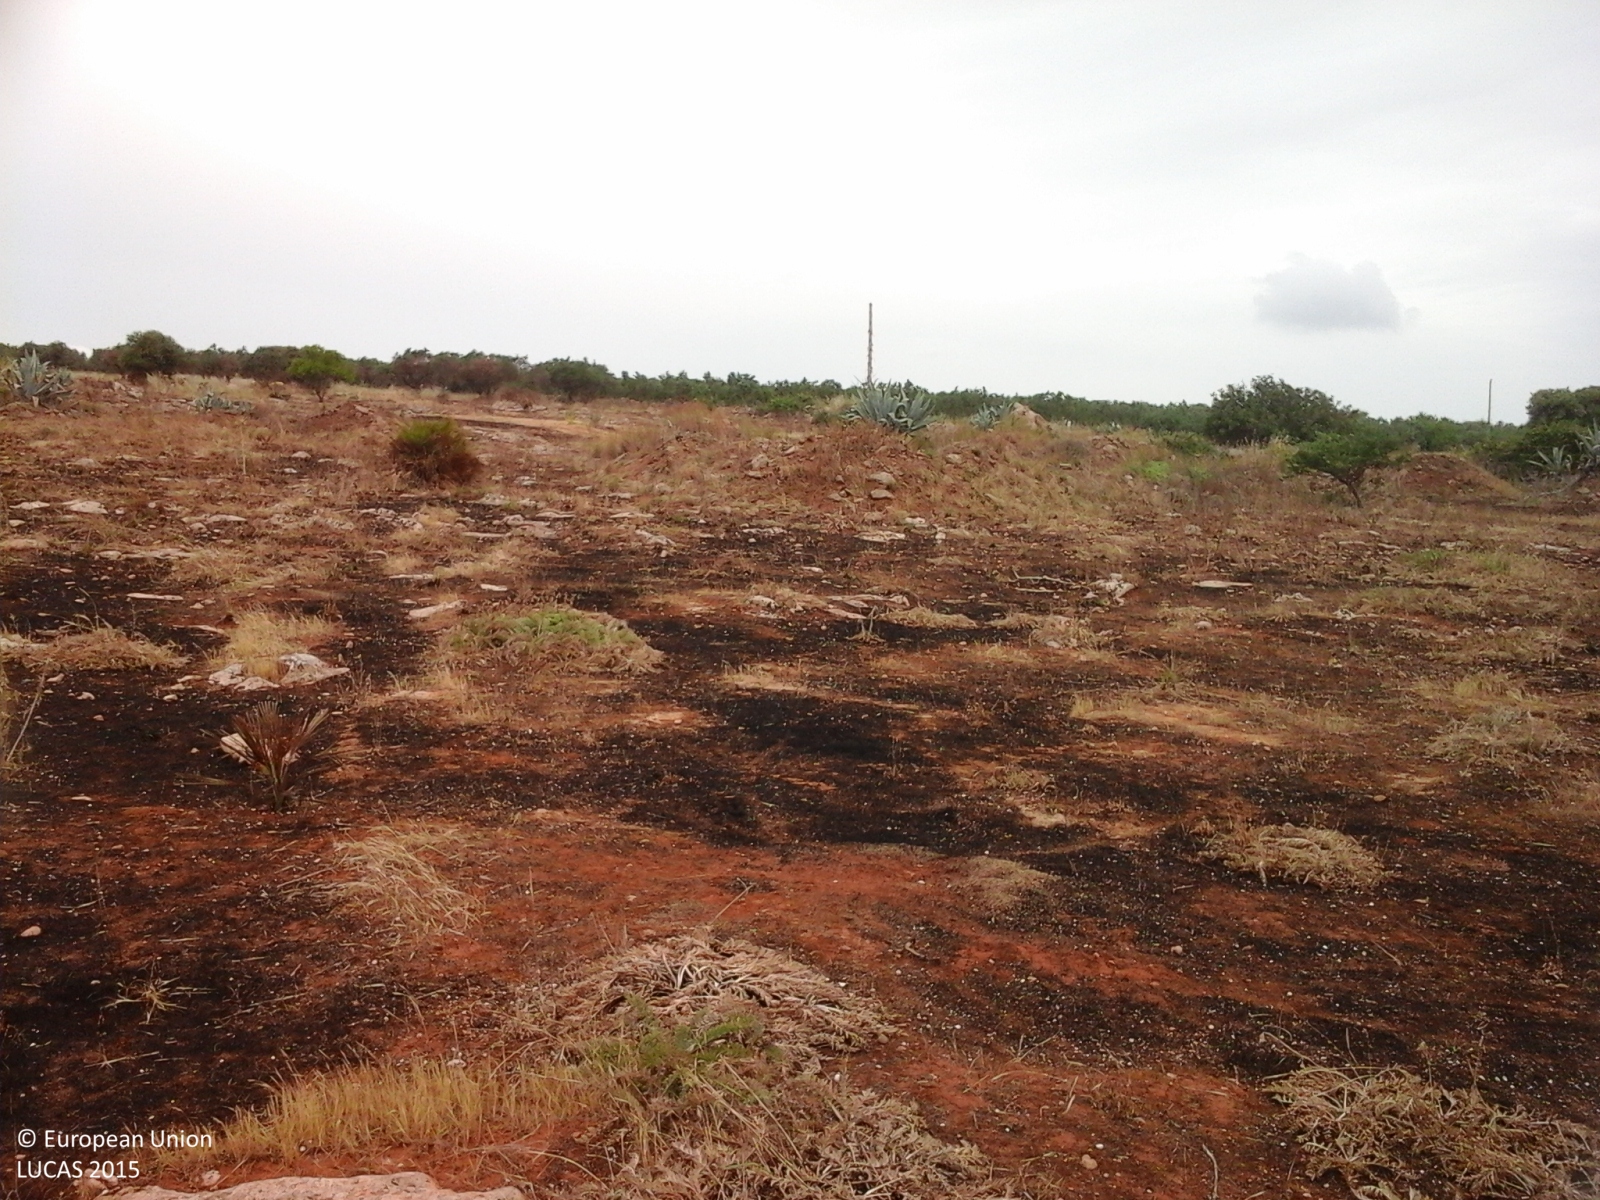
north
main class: Grassland
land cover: Grassland with sparse tree/shrub cover
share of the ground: > 75 %
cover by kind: consolidated bare surface 65 %, herbaceous plants 20 %, shrubs 10 %, coniferous forest trees 5 %
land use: Semi-natural and natural areas not in use
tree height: < 5 m
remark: Burnt area
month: May
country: IT
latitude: 37.6168
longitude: 12.7546
